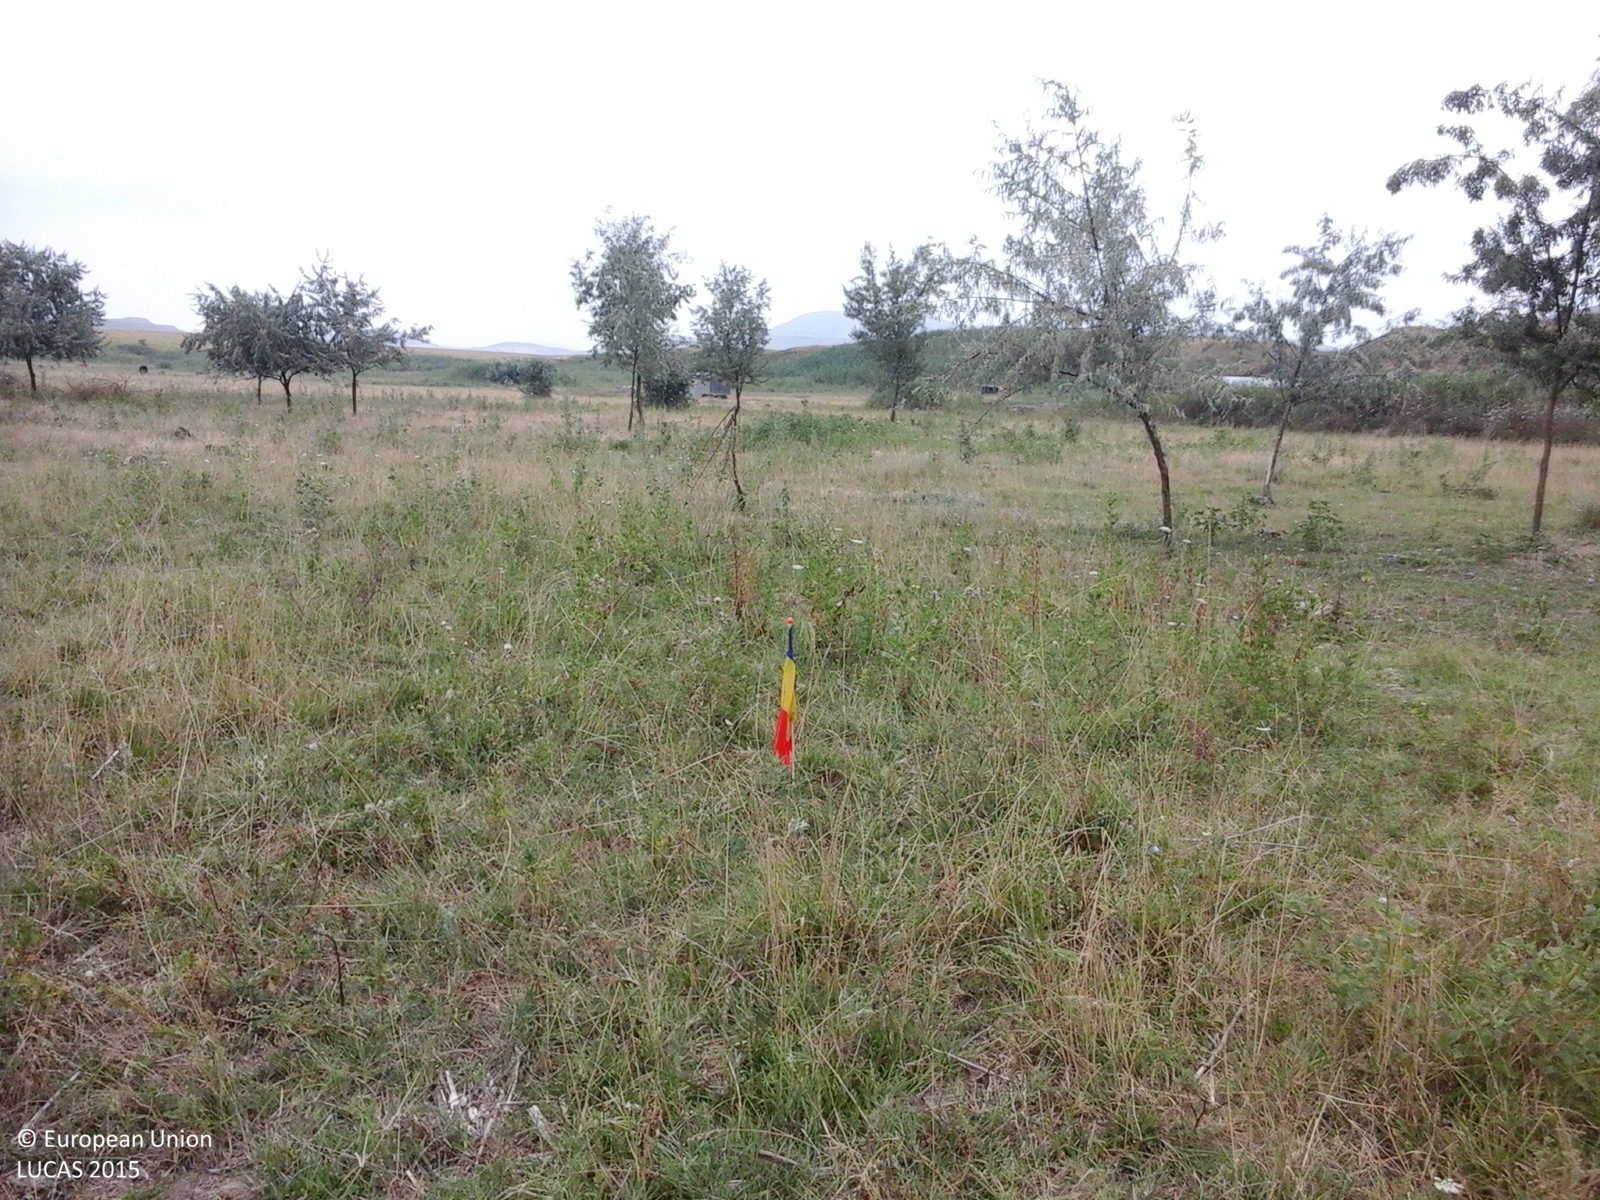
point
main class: Grassland
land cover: Grassland with sparse tree/shrub cover
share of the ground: > 75 %
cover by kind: herbaceous plants 85 %, shrubs 10 %, broadleaved forest trees 5 %
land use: Semi-natural and natural areas not in use
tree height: > 5 m
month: July
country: RO
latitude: 45.0645
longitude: 28.2180
